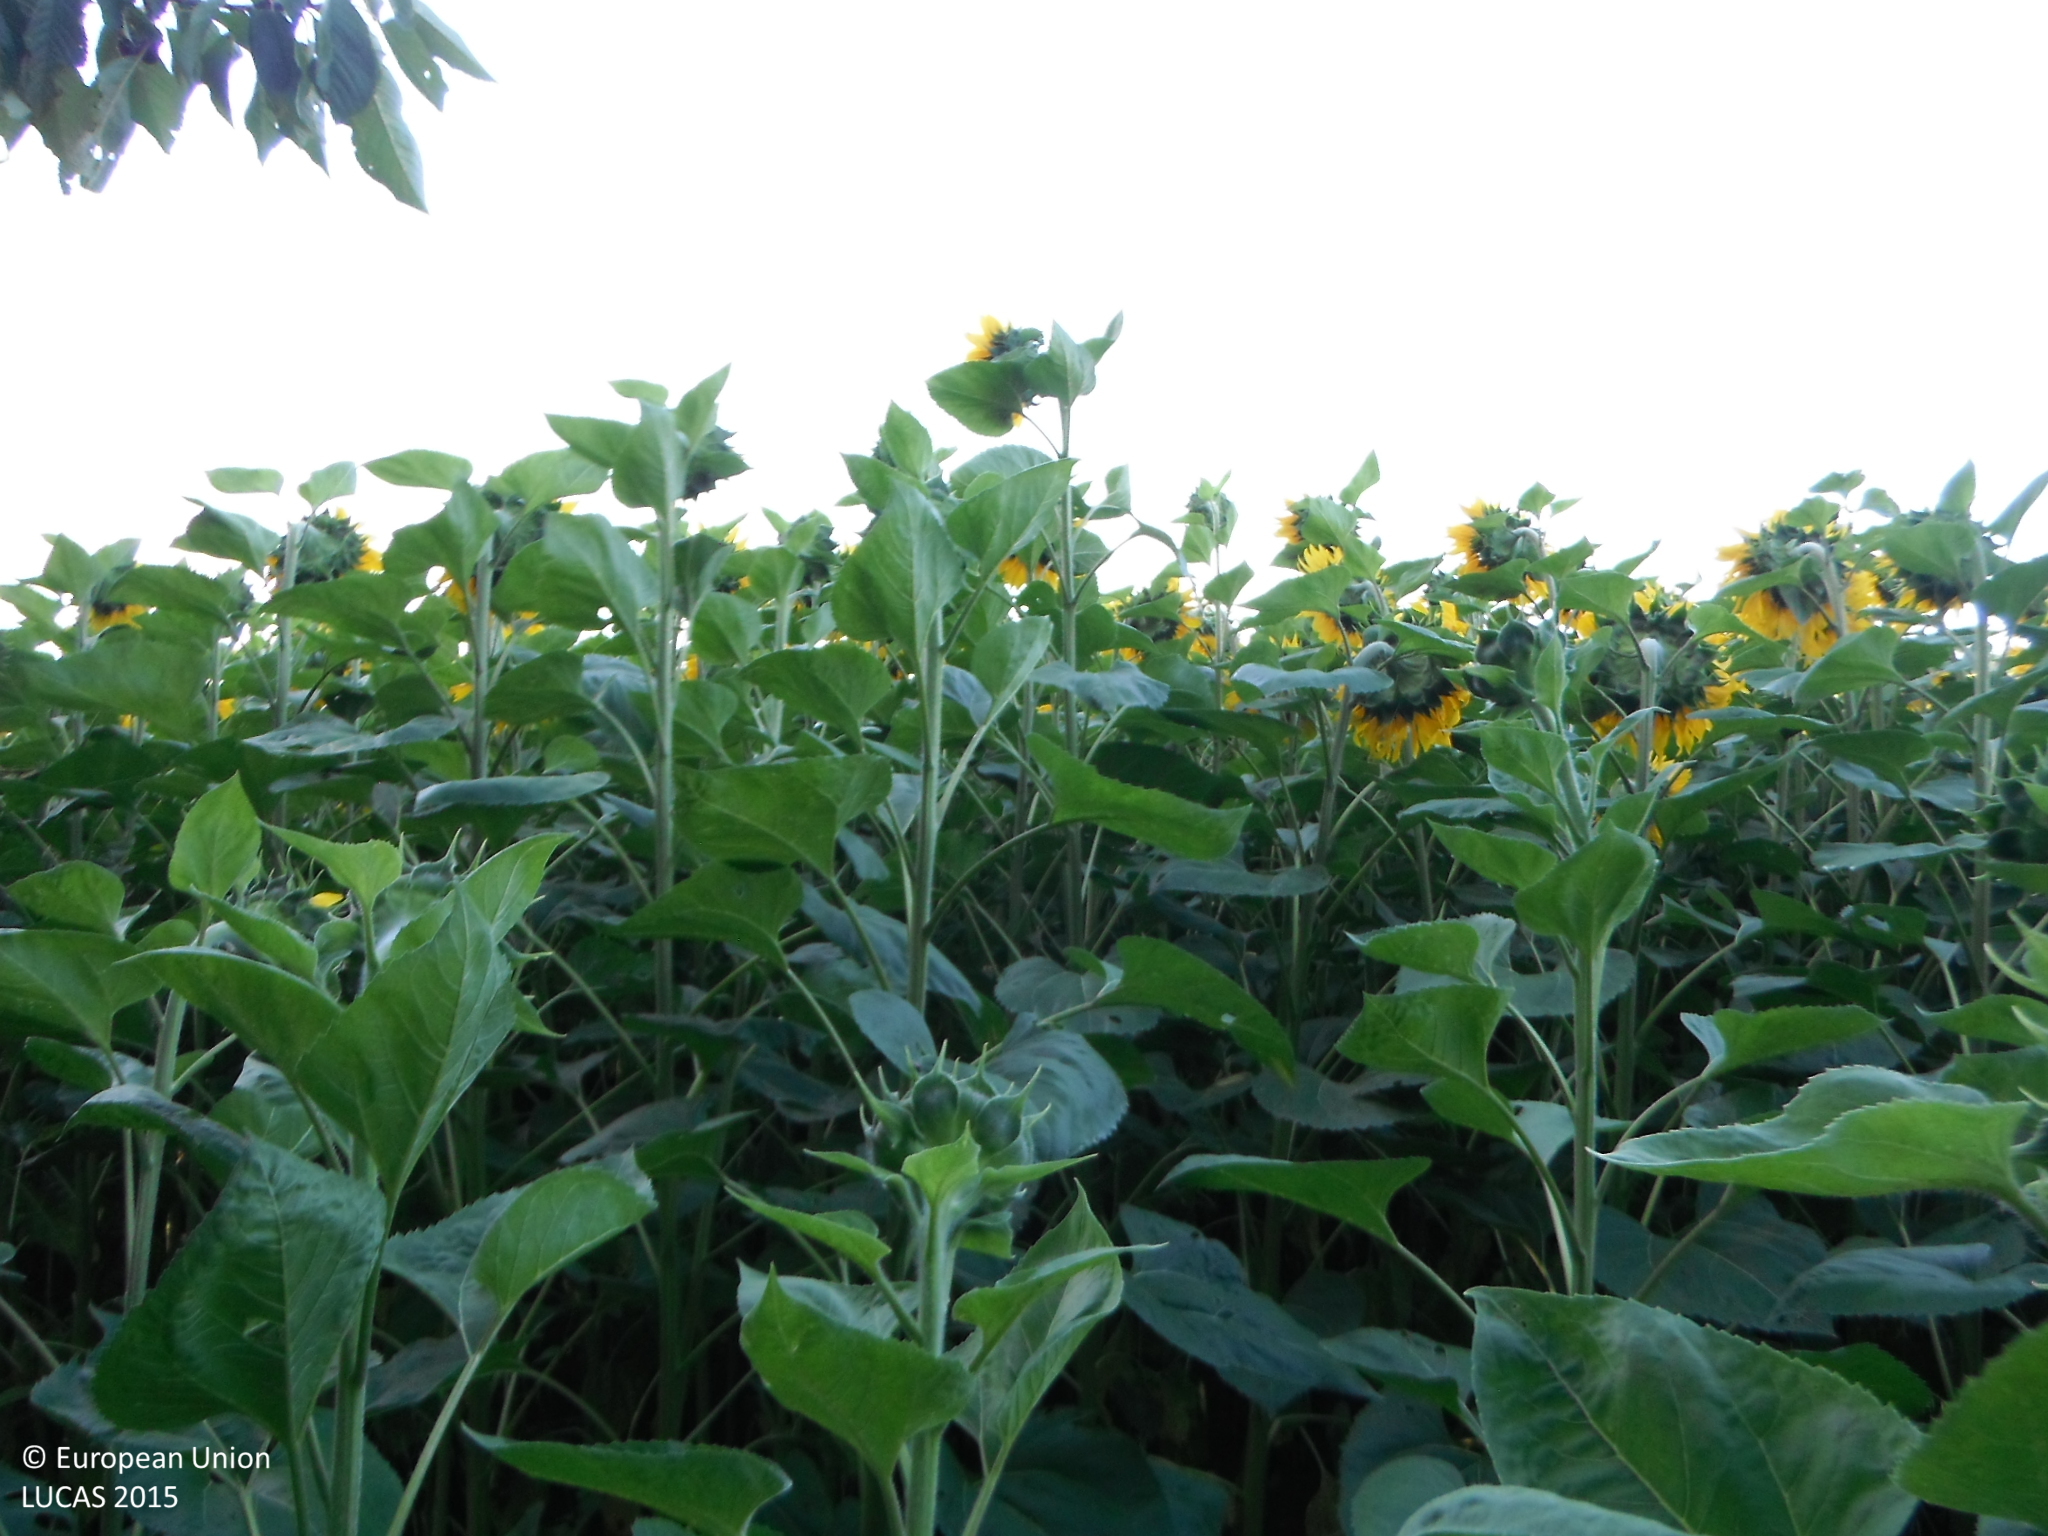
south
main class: Cropland
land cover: Sunflower
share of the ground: > 75 %
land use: Agriculture (excluding fallow land and kitchen gardens)
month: July
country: SK
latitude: 48.5189
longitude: 17.6337
